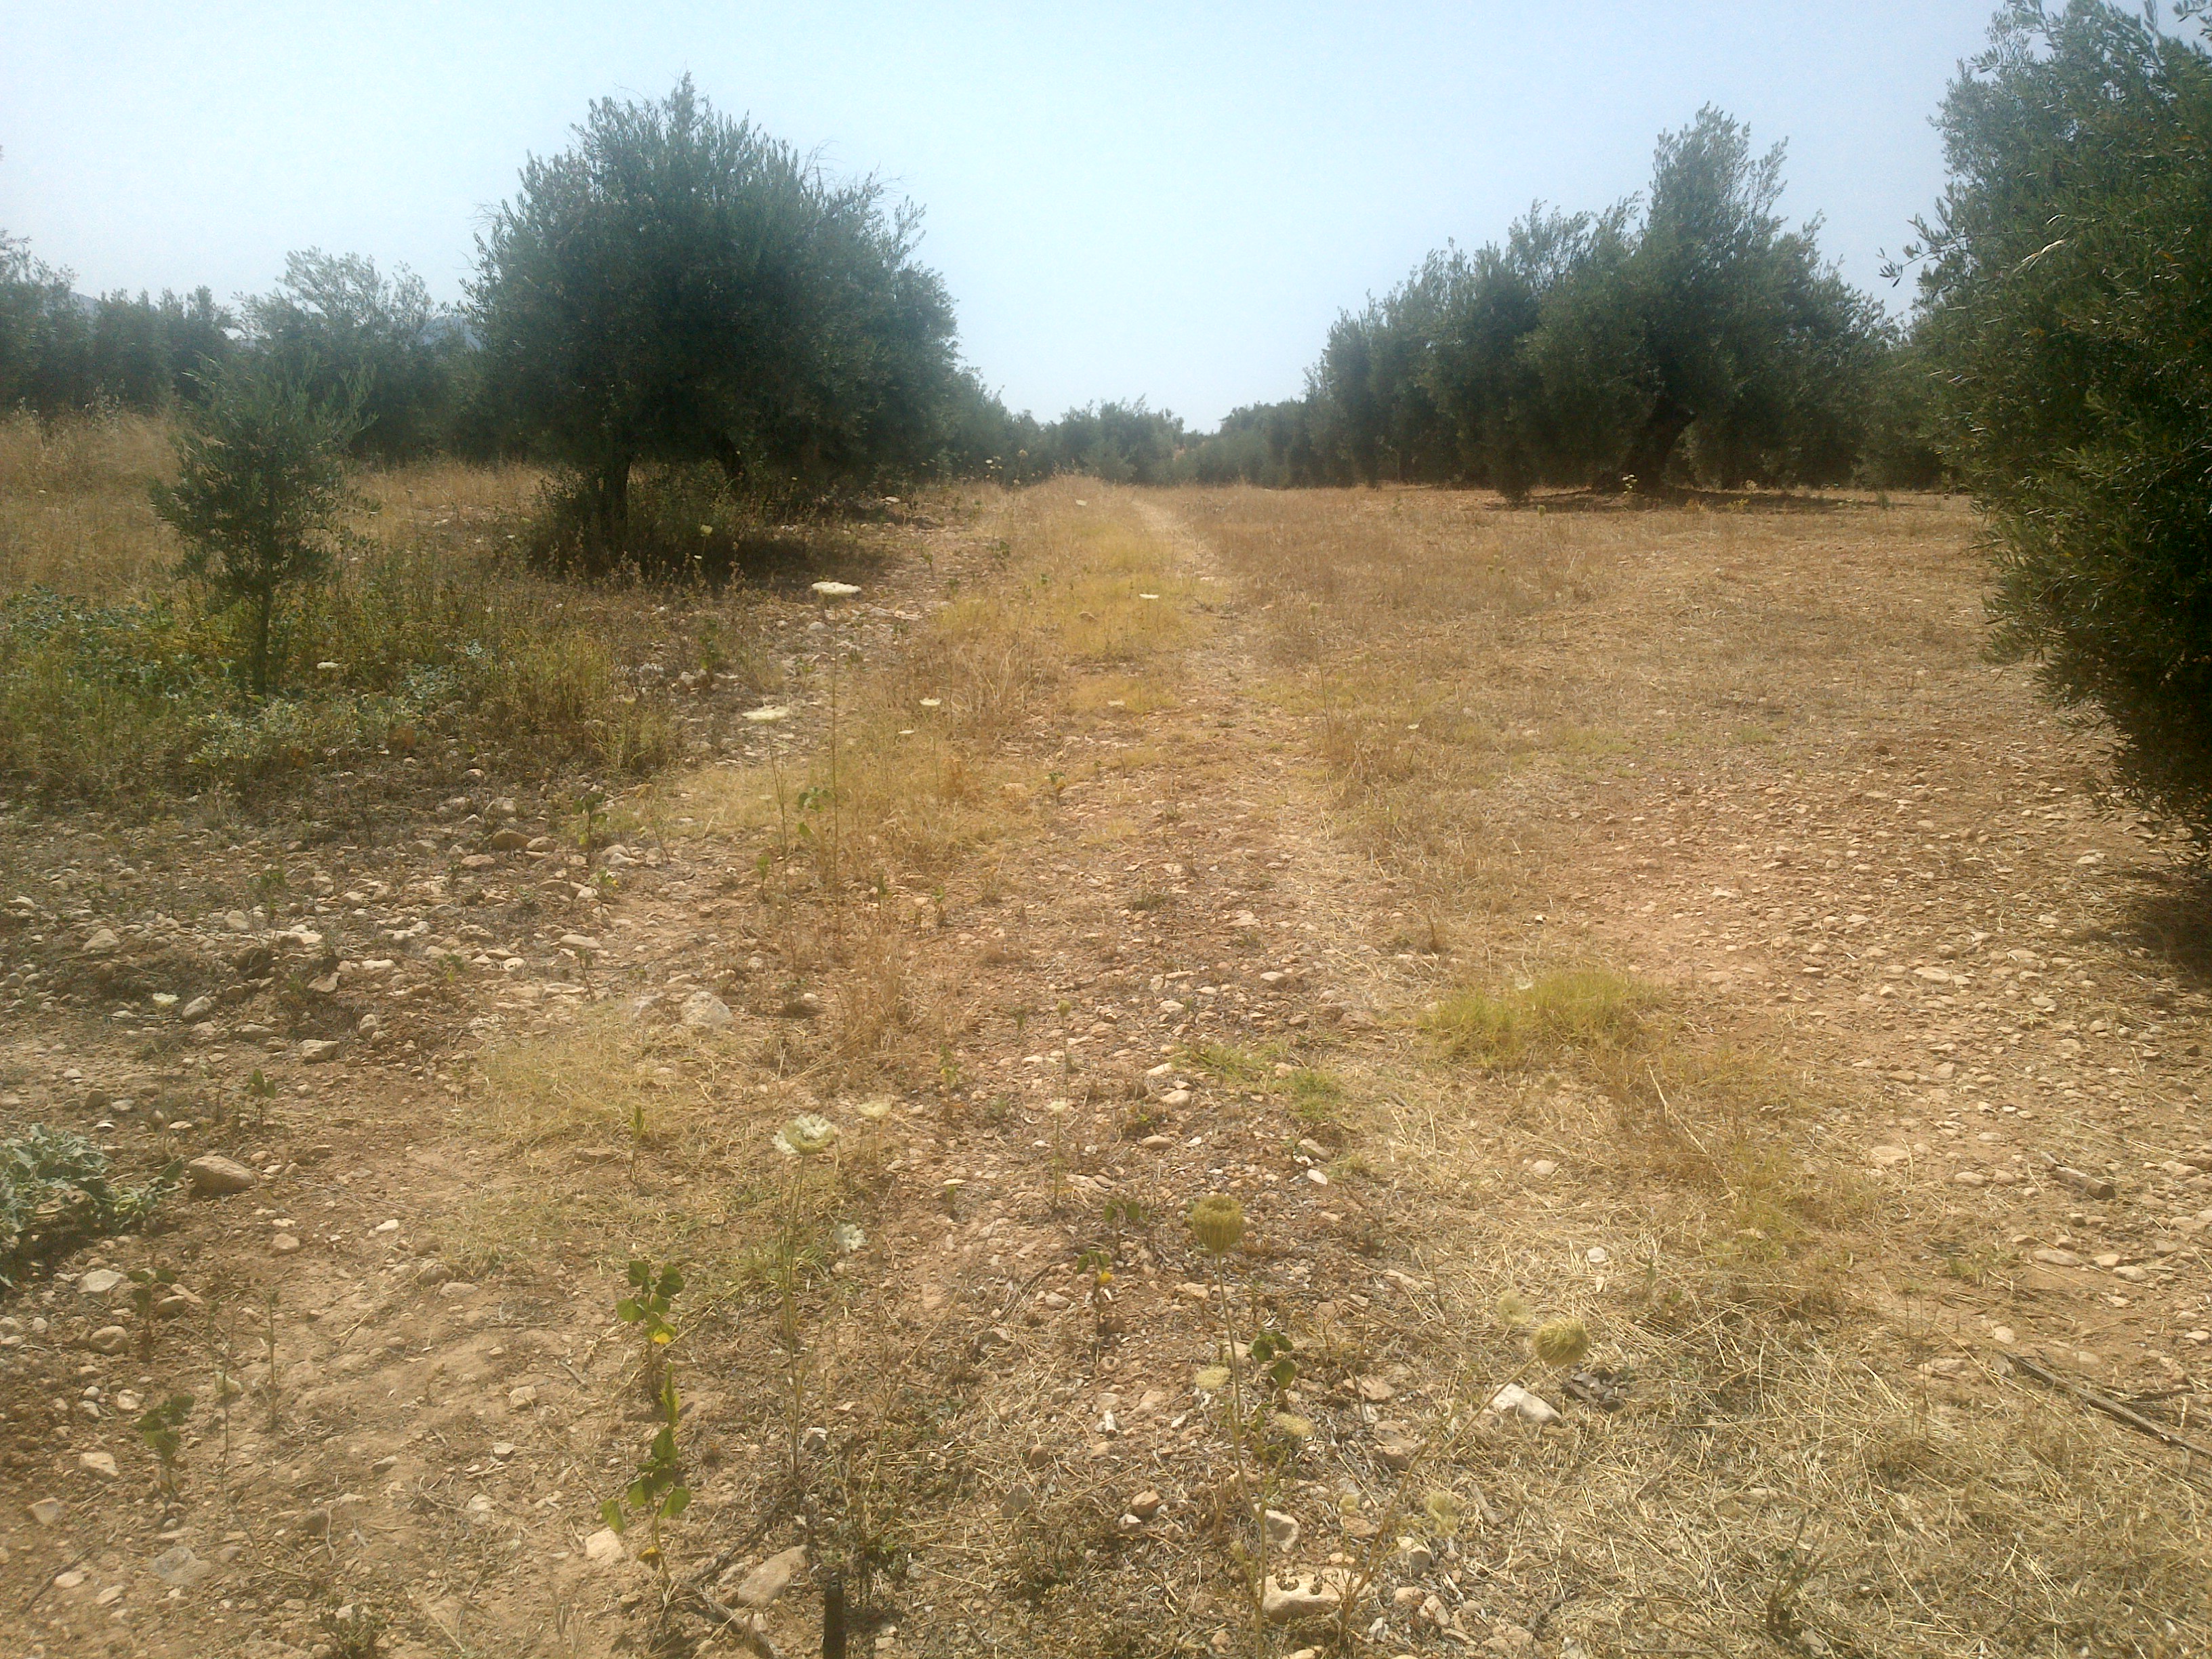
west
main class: Cropland
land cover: Olive groves
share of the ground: 25 - 50 %
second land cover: Spontaneously vegetated surfaces
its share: 10 - 25 %
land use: Agriculture (excluding fallow land and kitchen gardens)
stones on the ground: 25 - 50 %
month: June
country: ES
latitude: 37.5714
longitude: -4.2345
